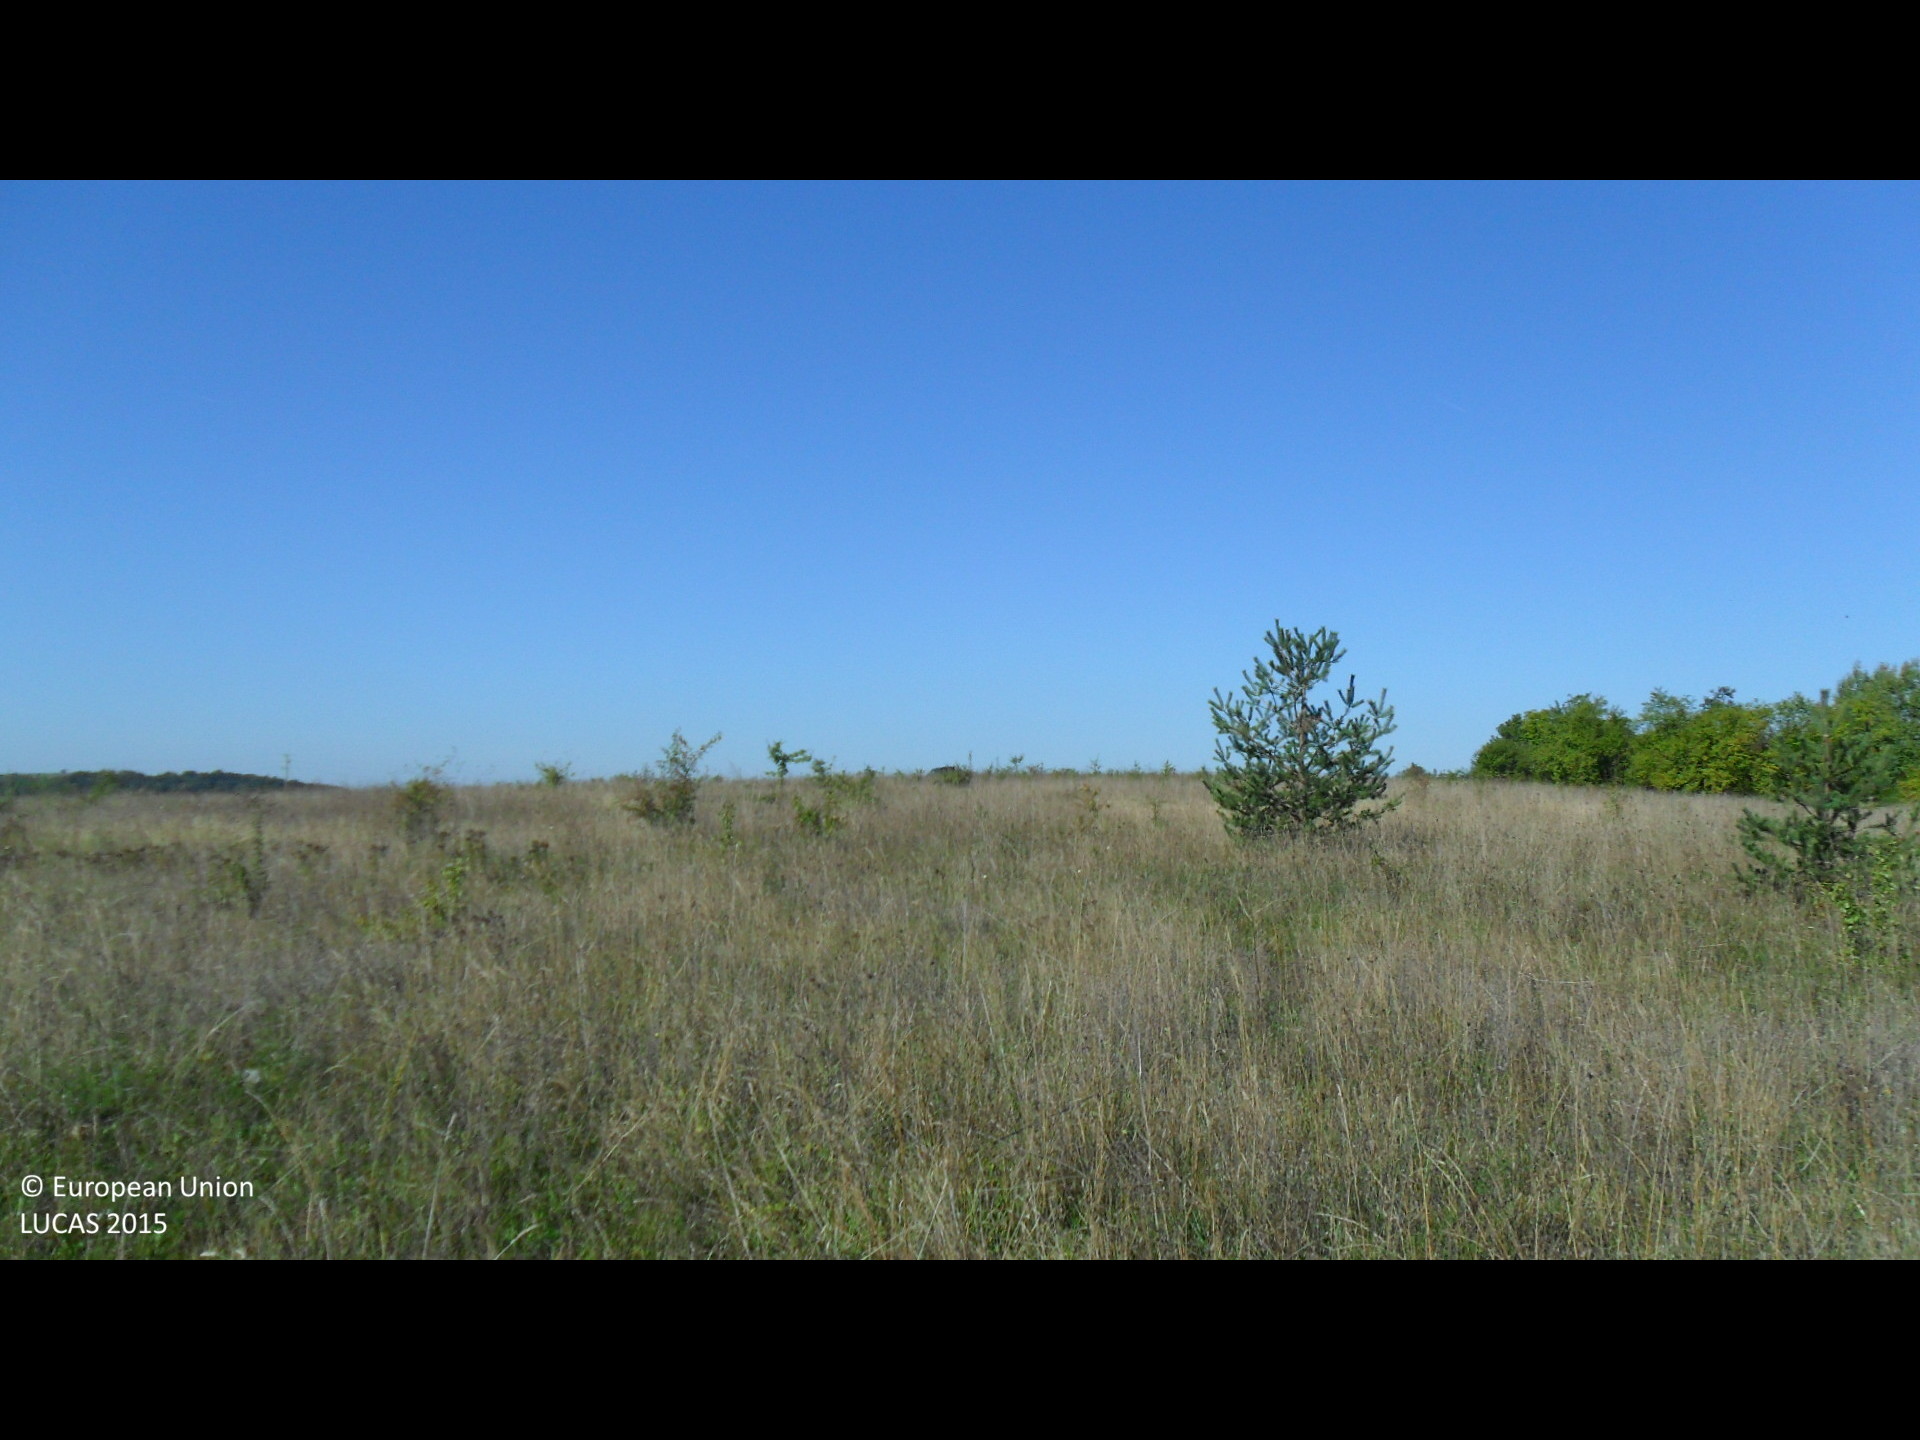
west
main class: Grassland
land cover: Grassland without tree/shrub cover
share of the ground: > 75 %
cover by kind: herbaceous plants 100 %
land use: Semi-natural and natural areas not in use
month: October
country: BG
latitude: 43.1703
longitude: 26.2455
